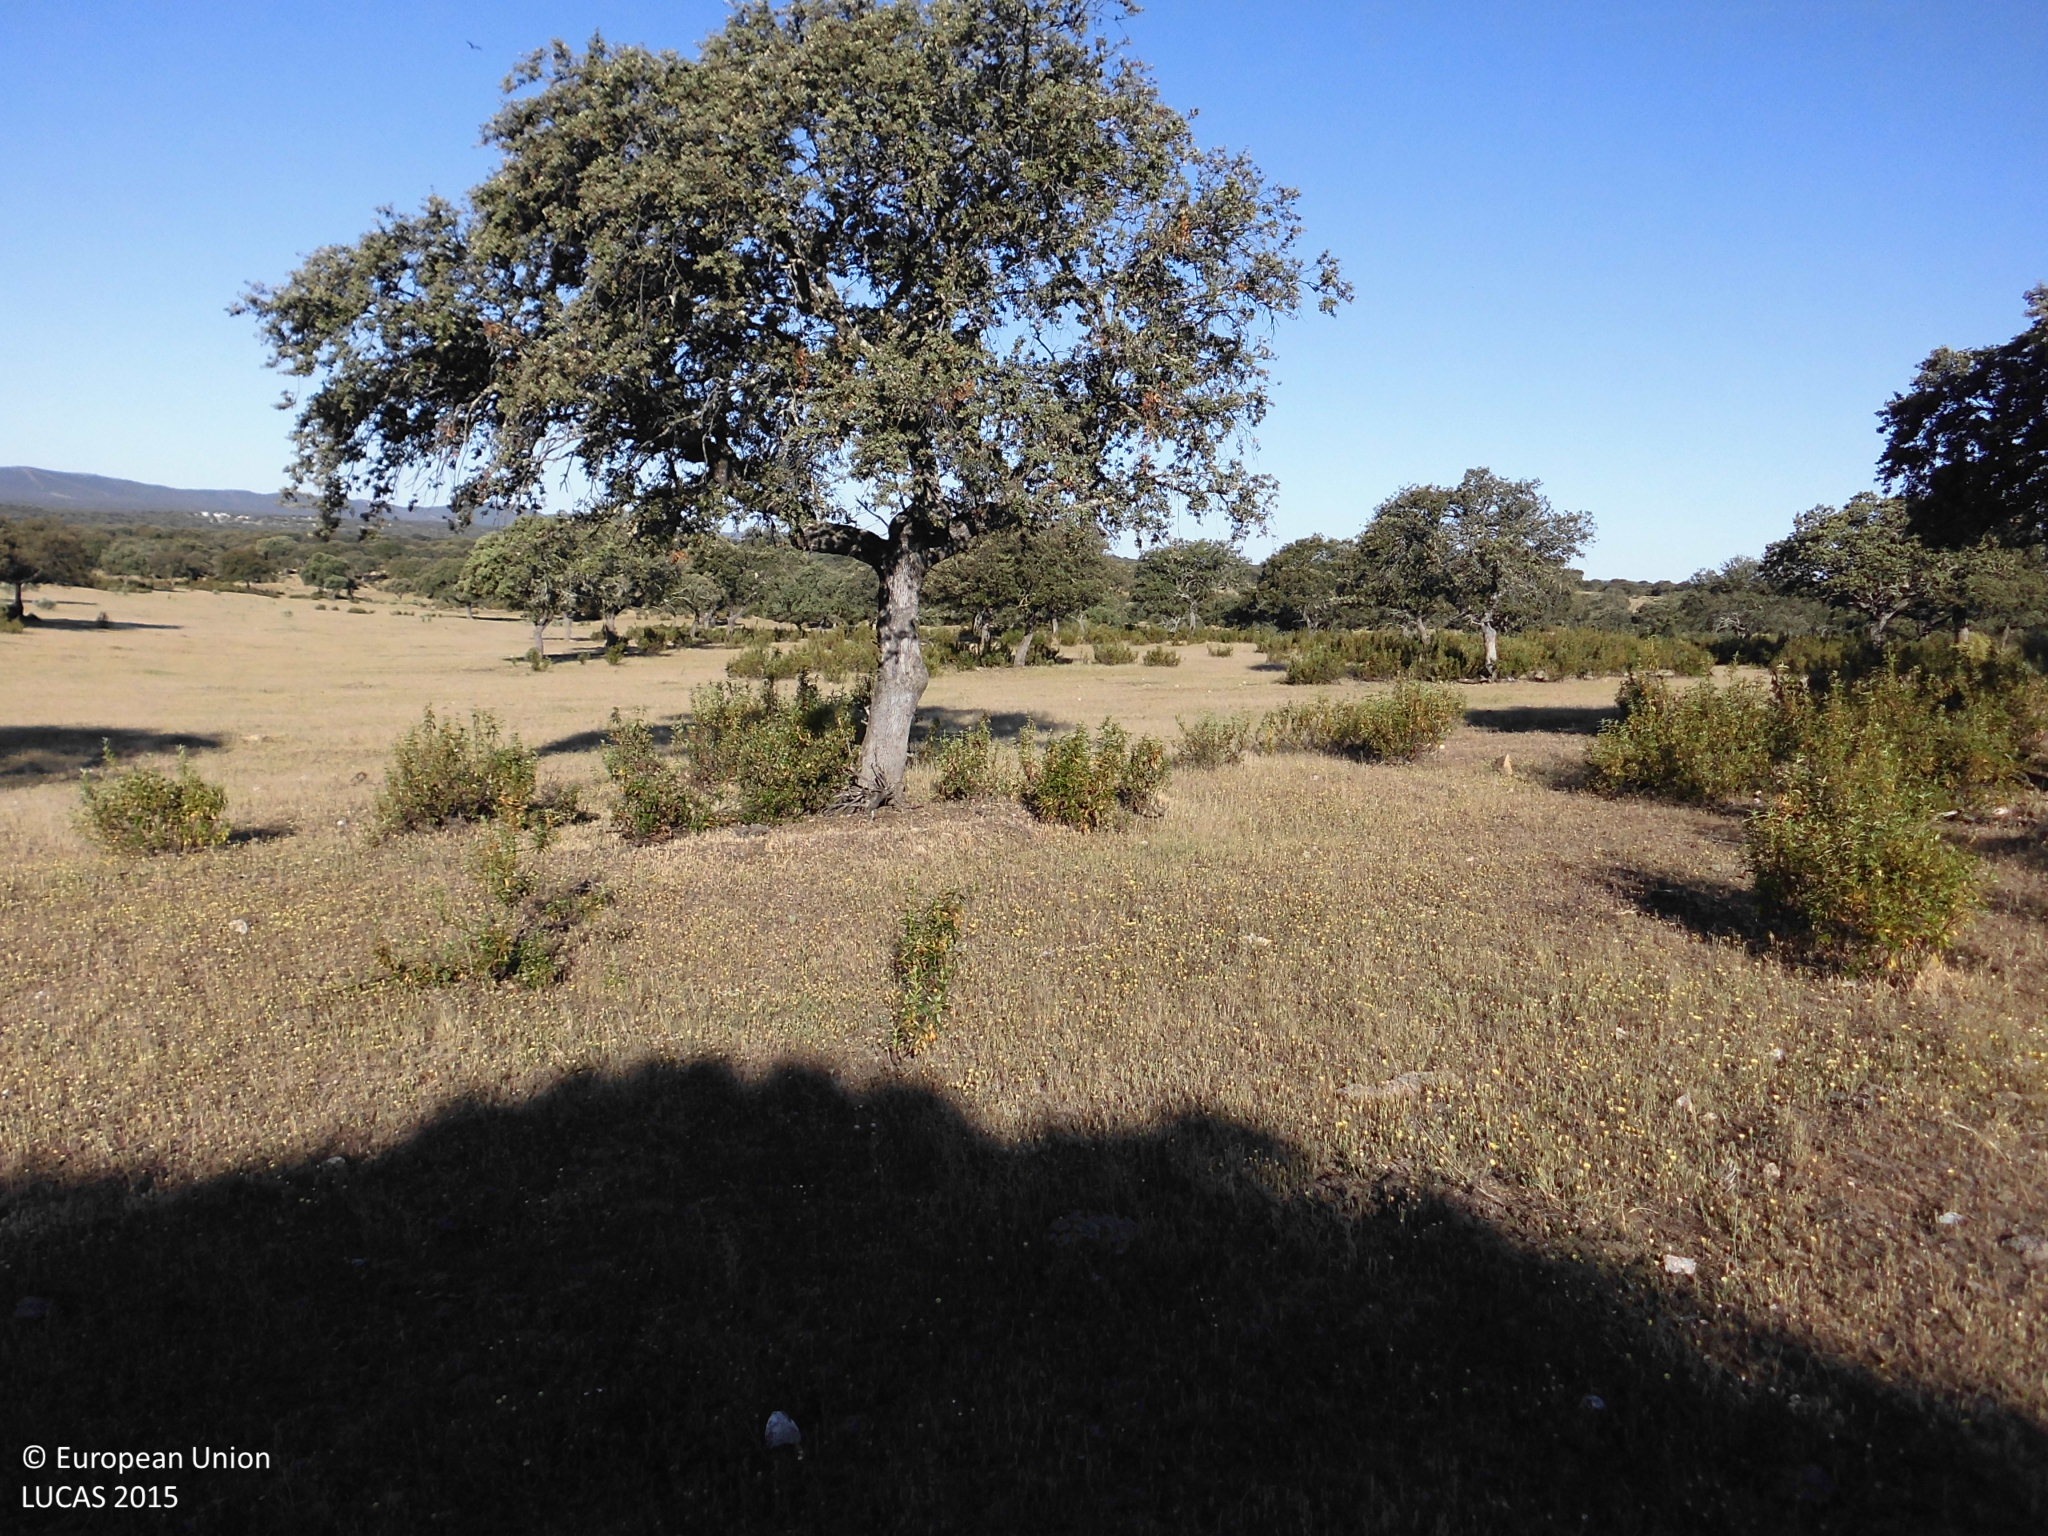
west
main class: Woodland
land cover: Broadleaved woodland
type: broadleaved evergreen forest
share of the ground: 10 - 25 %
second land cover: Grassland without tree/shrub cover
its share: > 75 %
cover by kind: herbaceous plants 50 %, broadleaved forest trees 25 %, shrubs 25 %
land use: Forestry
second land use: Agriculture (excluding fallow land and kitchen gardens)
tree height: > 5 m
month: May
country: ES
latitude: 39.5083
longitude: -7.0041
